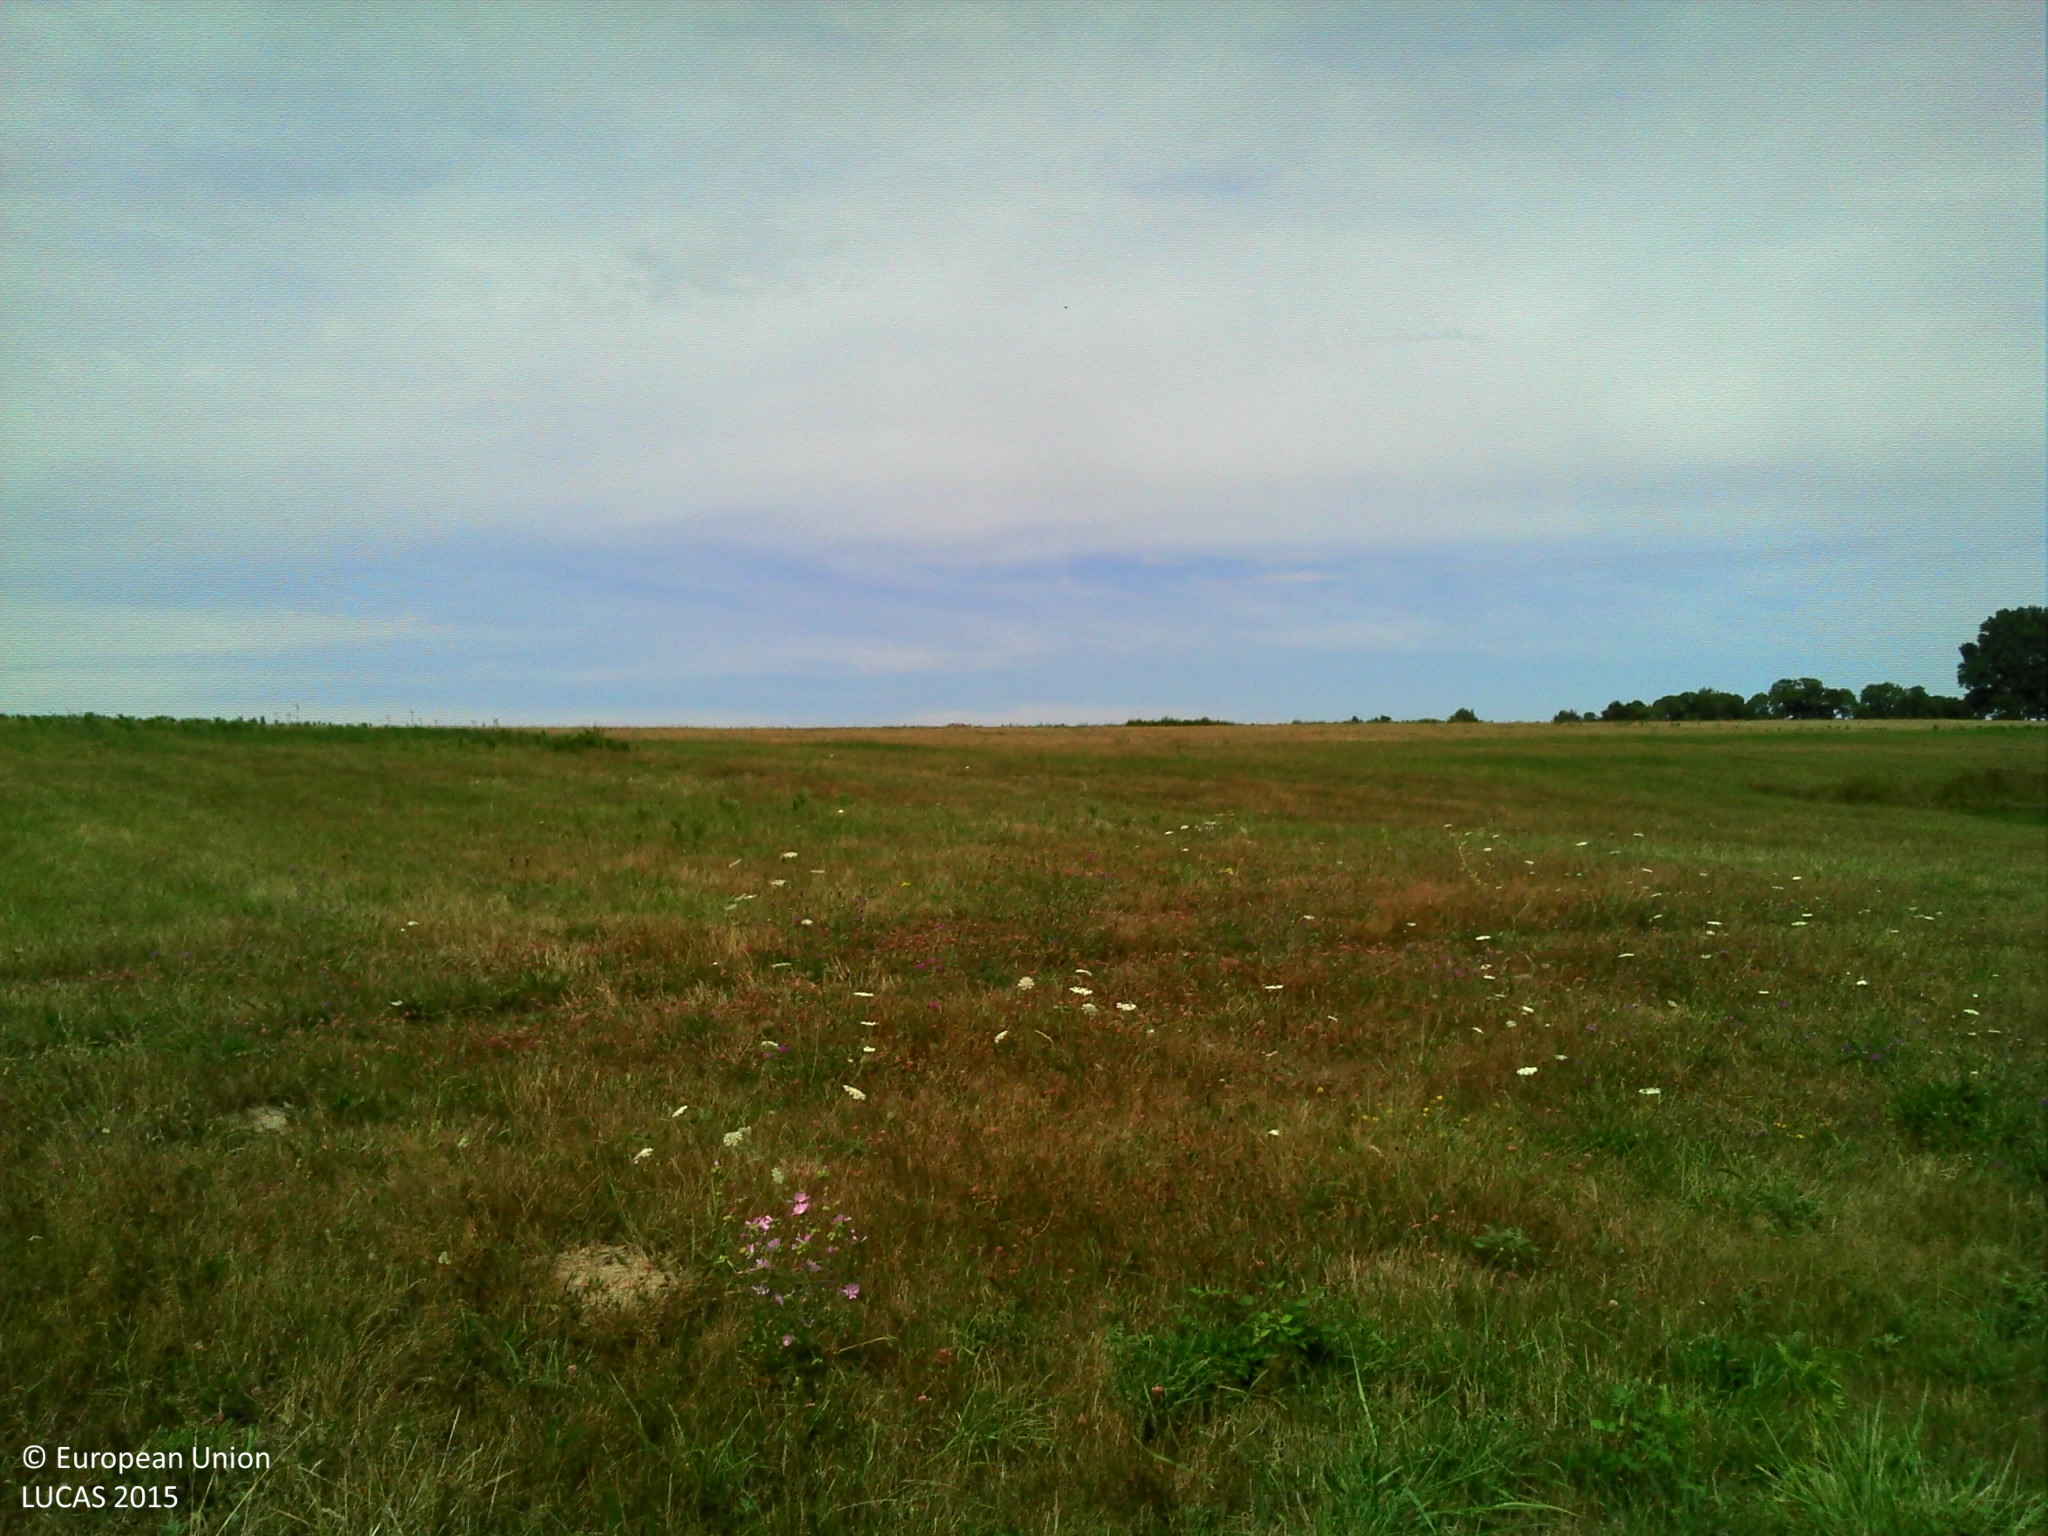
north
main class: Grassland
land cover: Grassland without tree/shrub cover
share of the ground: > 75 %
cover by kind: herbaceous plants 100 %
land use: Agriculture (excluding fallow land and kitchen gardens)
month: July
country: FR
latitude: 46.5575
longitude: 2.7566
